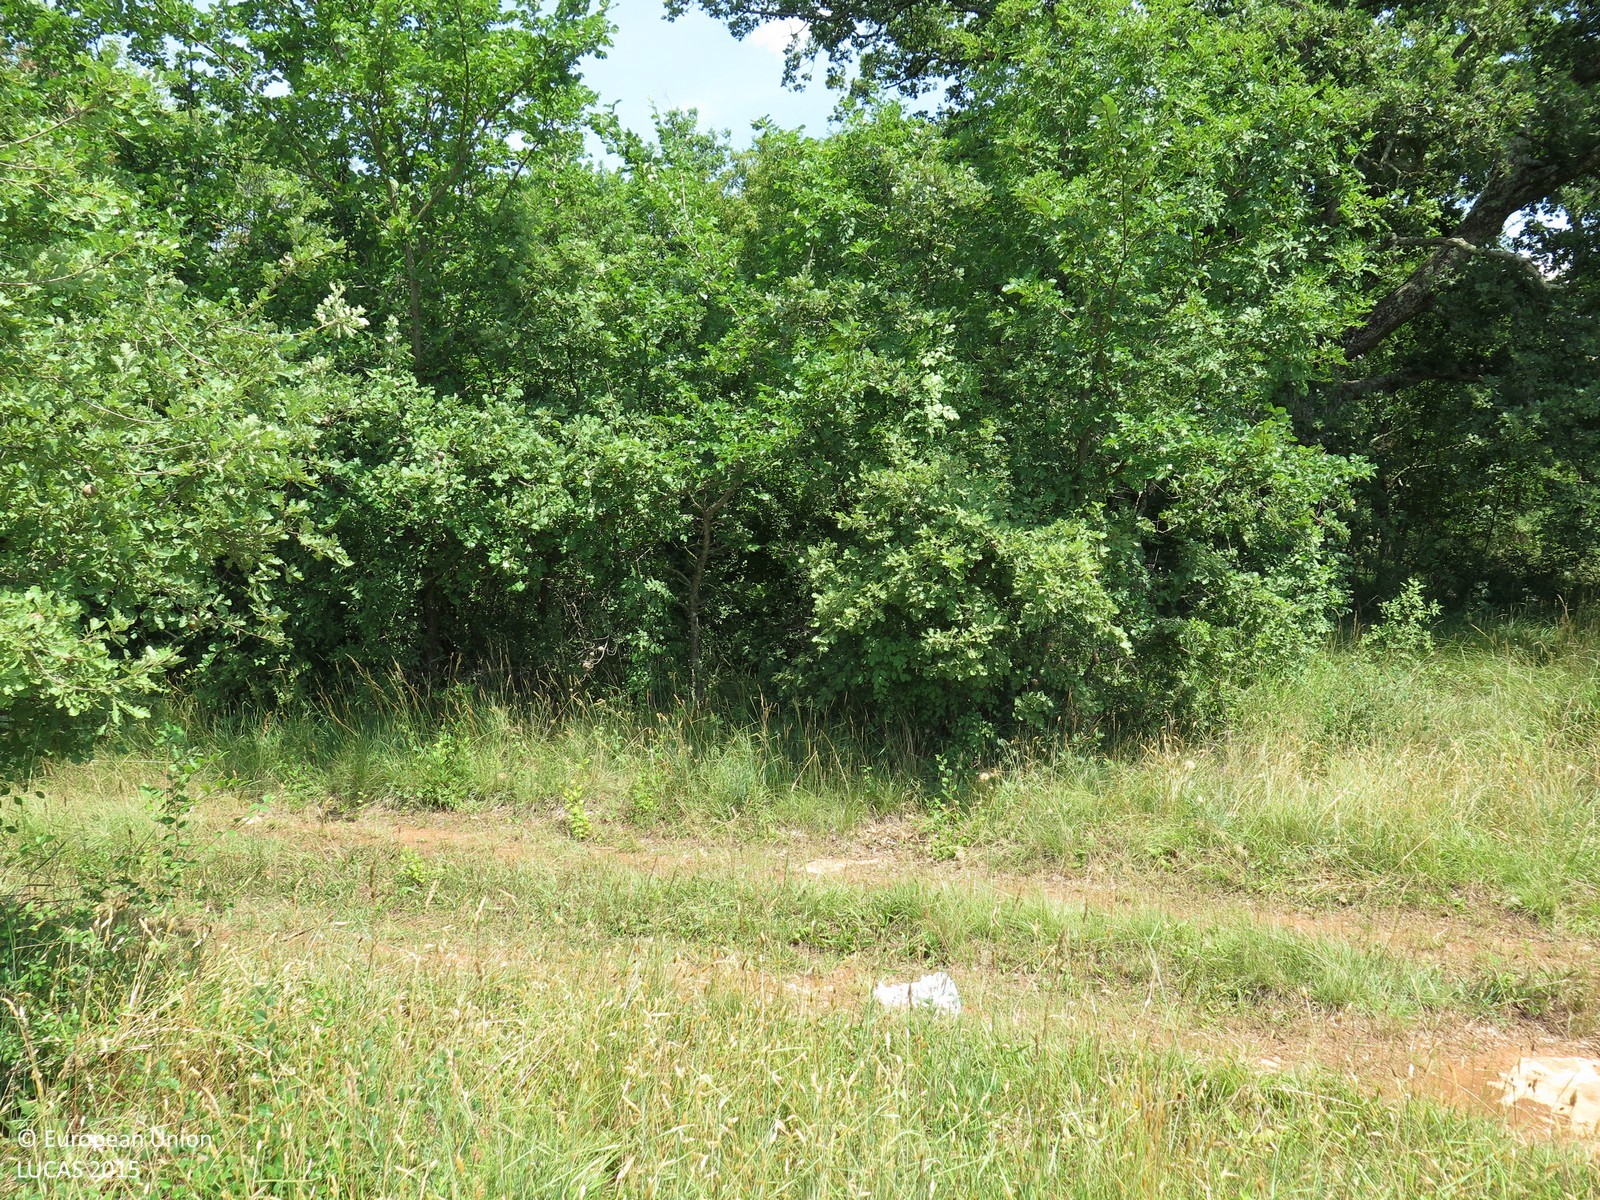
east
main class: Grassland
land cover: Grassland without tree/shrub cover
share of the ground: > 75 %
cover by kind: herbaceous plants 100 %
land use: Abandoned areas
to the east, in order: Grassland without tree/shrub cover; Tracks; Broadleaved woodland; Other structural elements; Grassland without tree/shrub cover; Broadleaved woodland; Dry stone walls; Broadleaved woodland
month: June
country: HR
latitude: 45.1691
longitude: 13.6972
